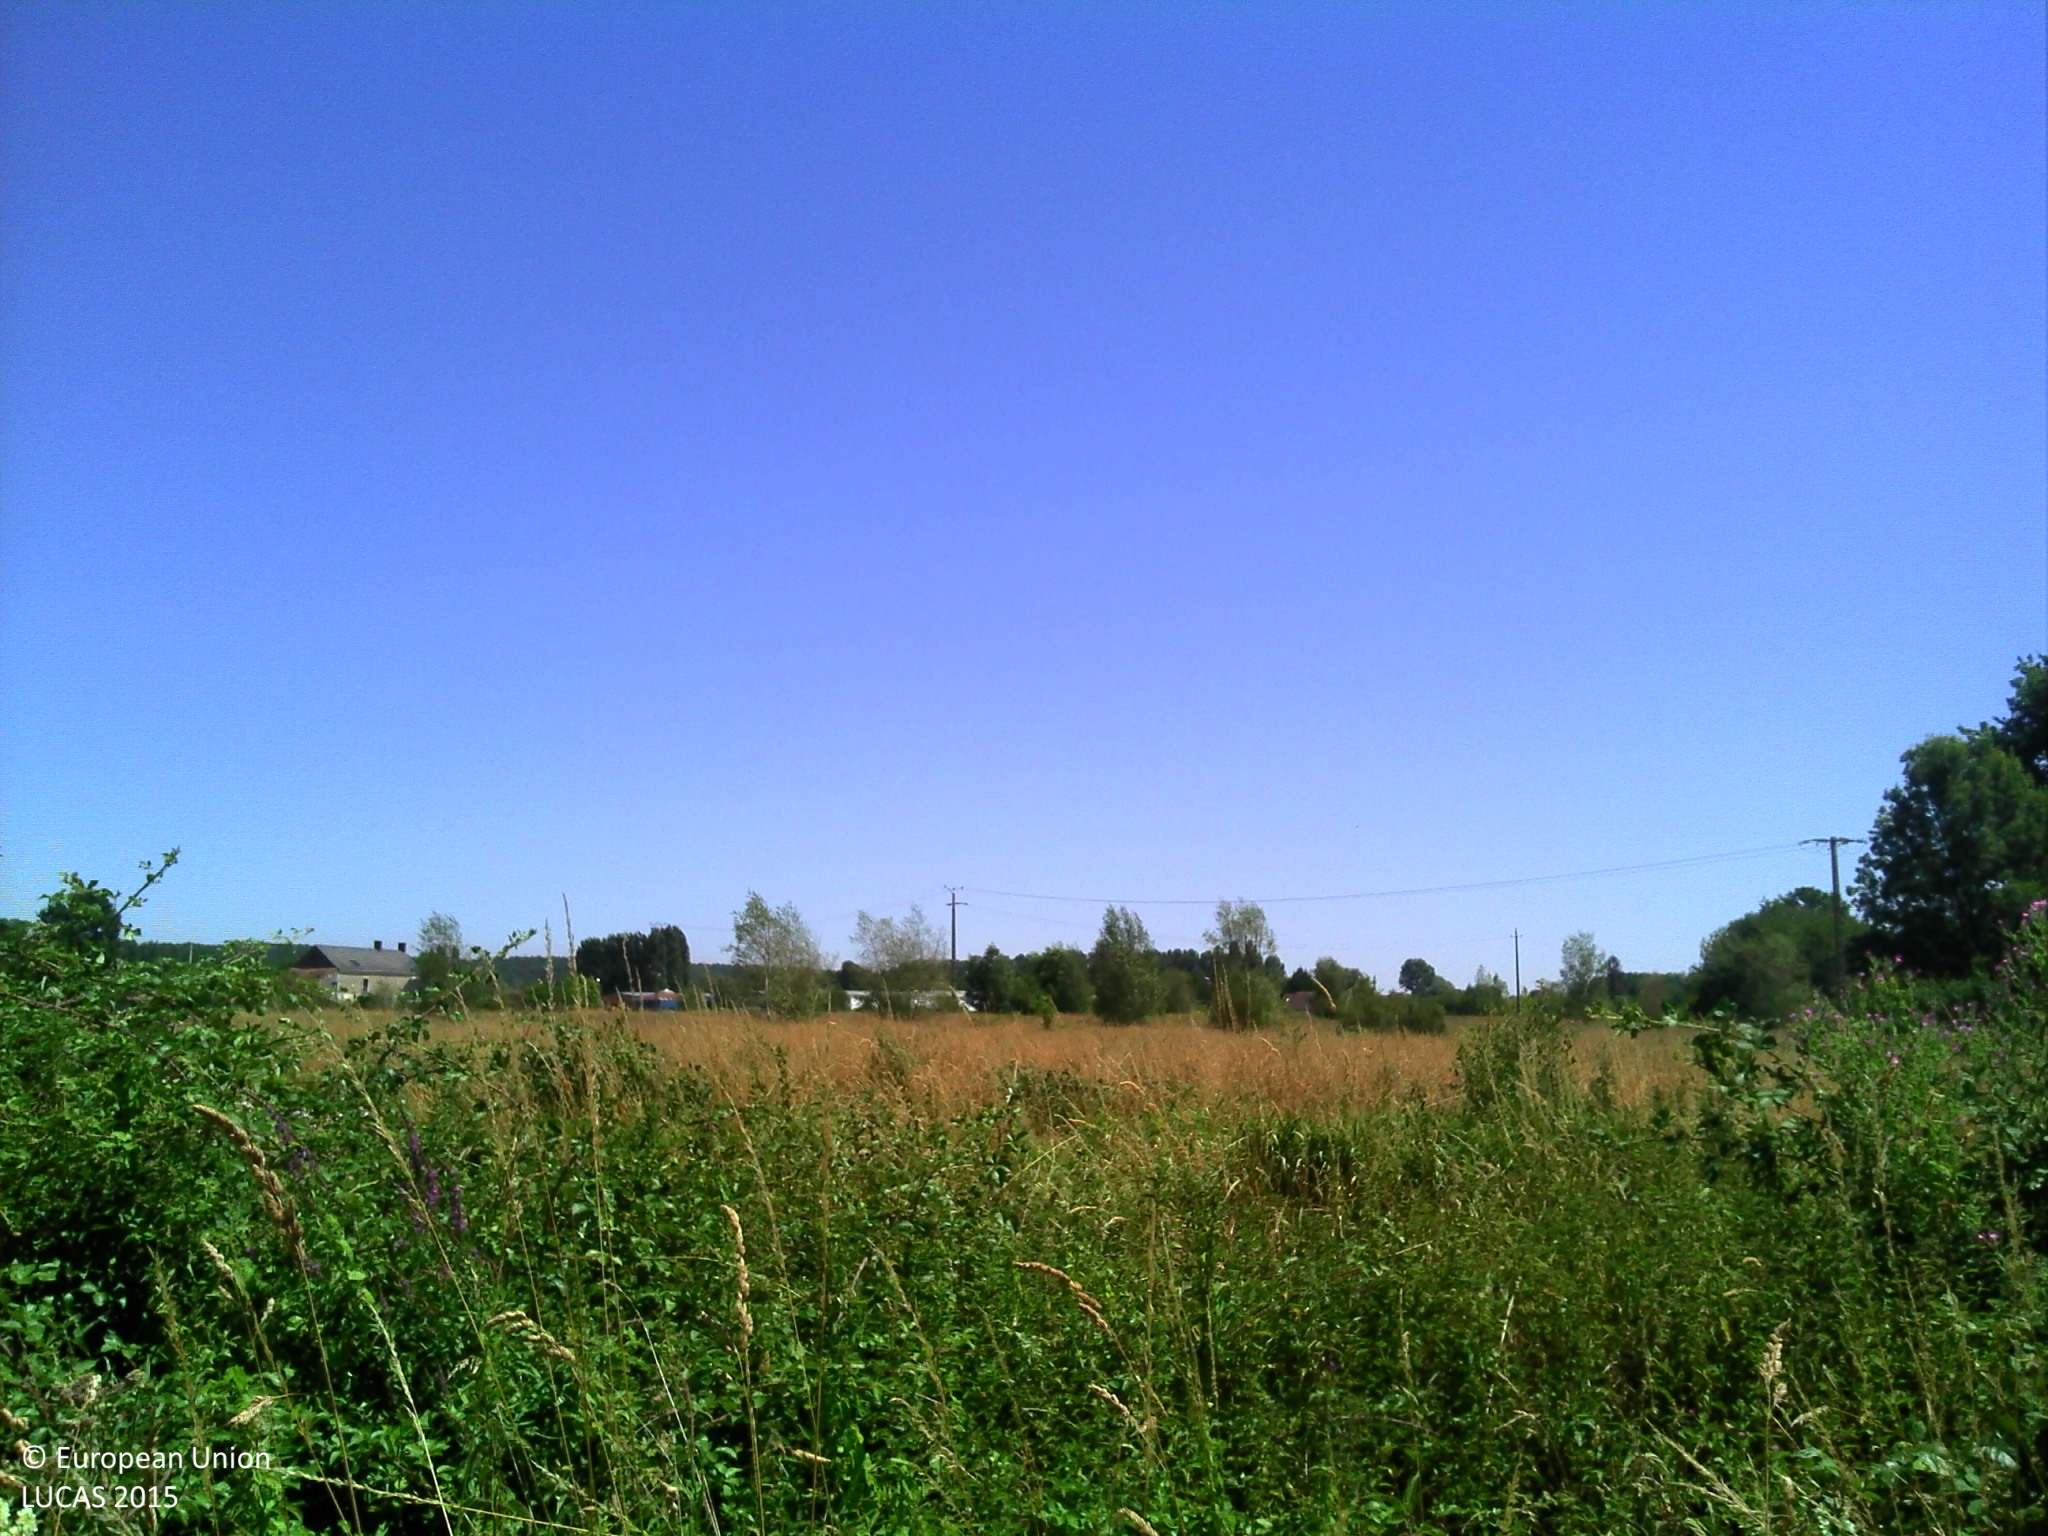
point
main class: Grassland
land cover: Grassland without tree/shrub cover
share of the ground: > 75 %
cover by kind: herbaceous plants 95 %, shrubs 5 %
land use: Agriculture (excluding fallow land and kitchen gardens)
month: July
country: FR
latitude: 47.6829
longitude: 0.2644
